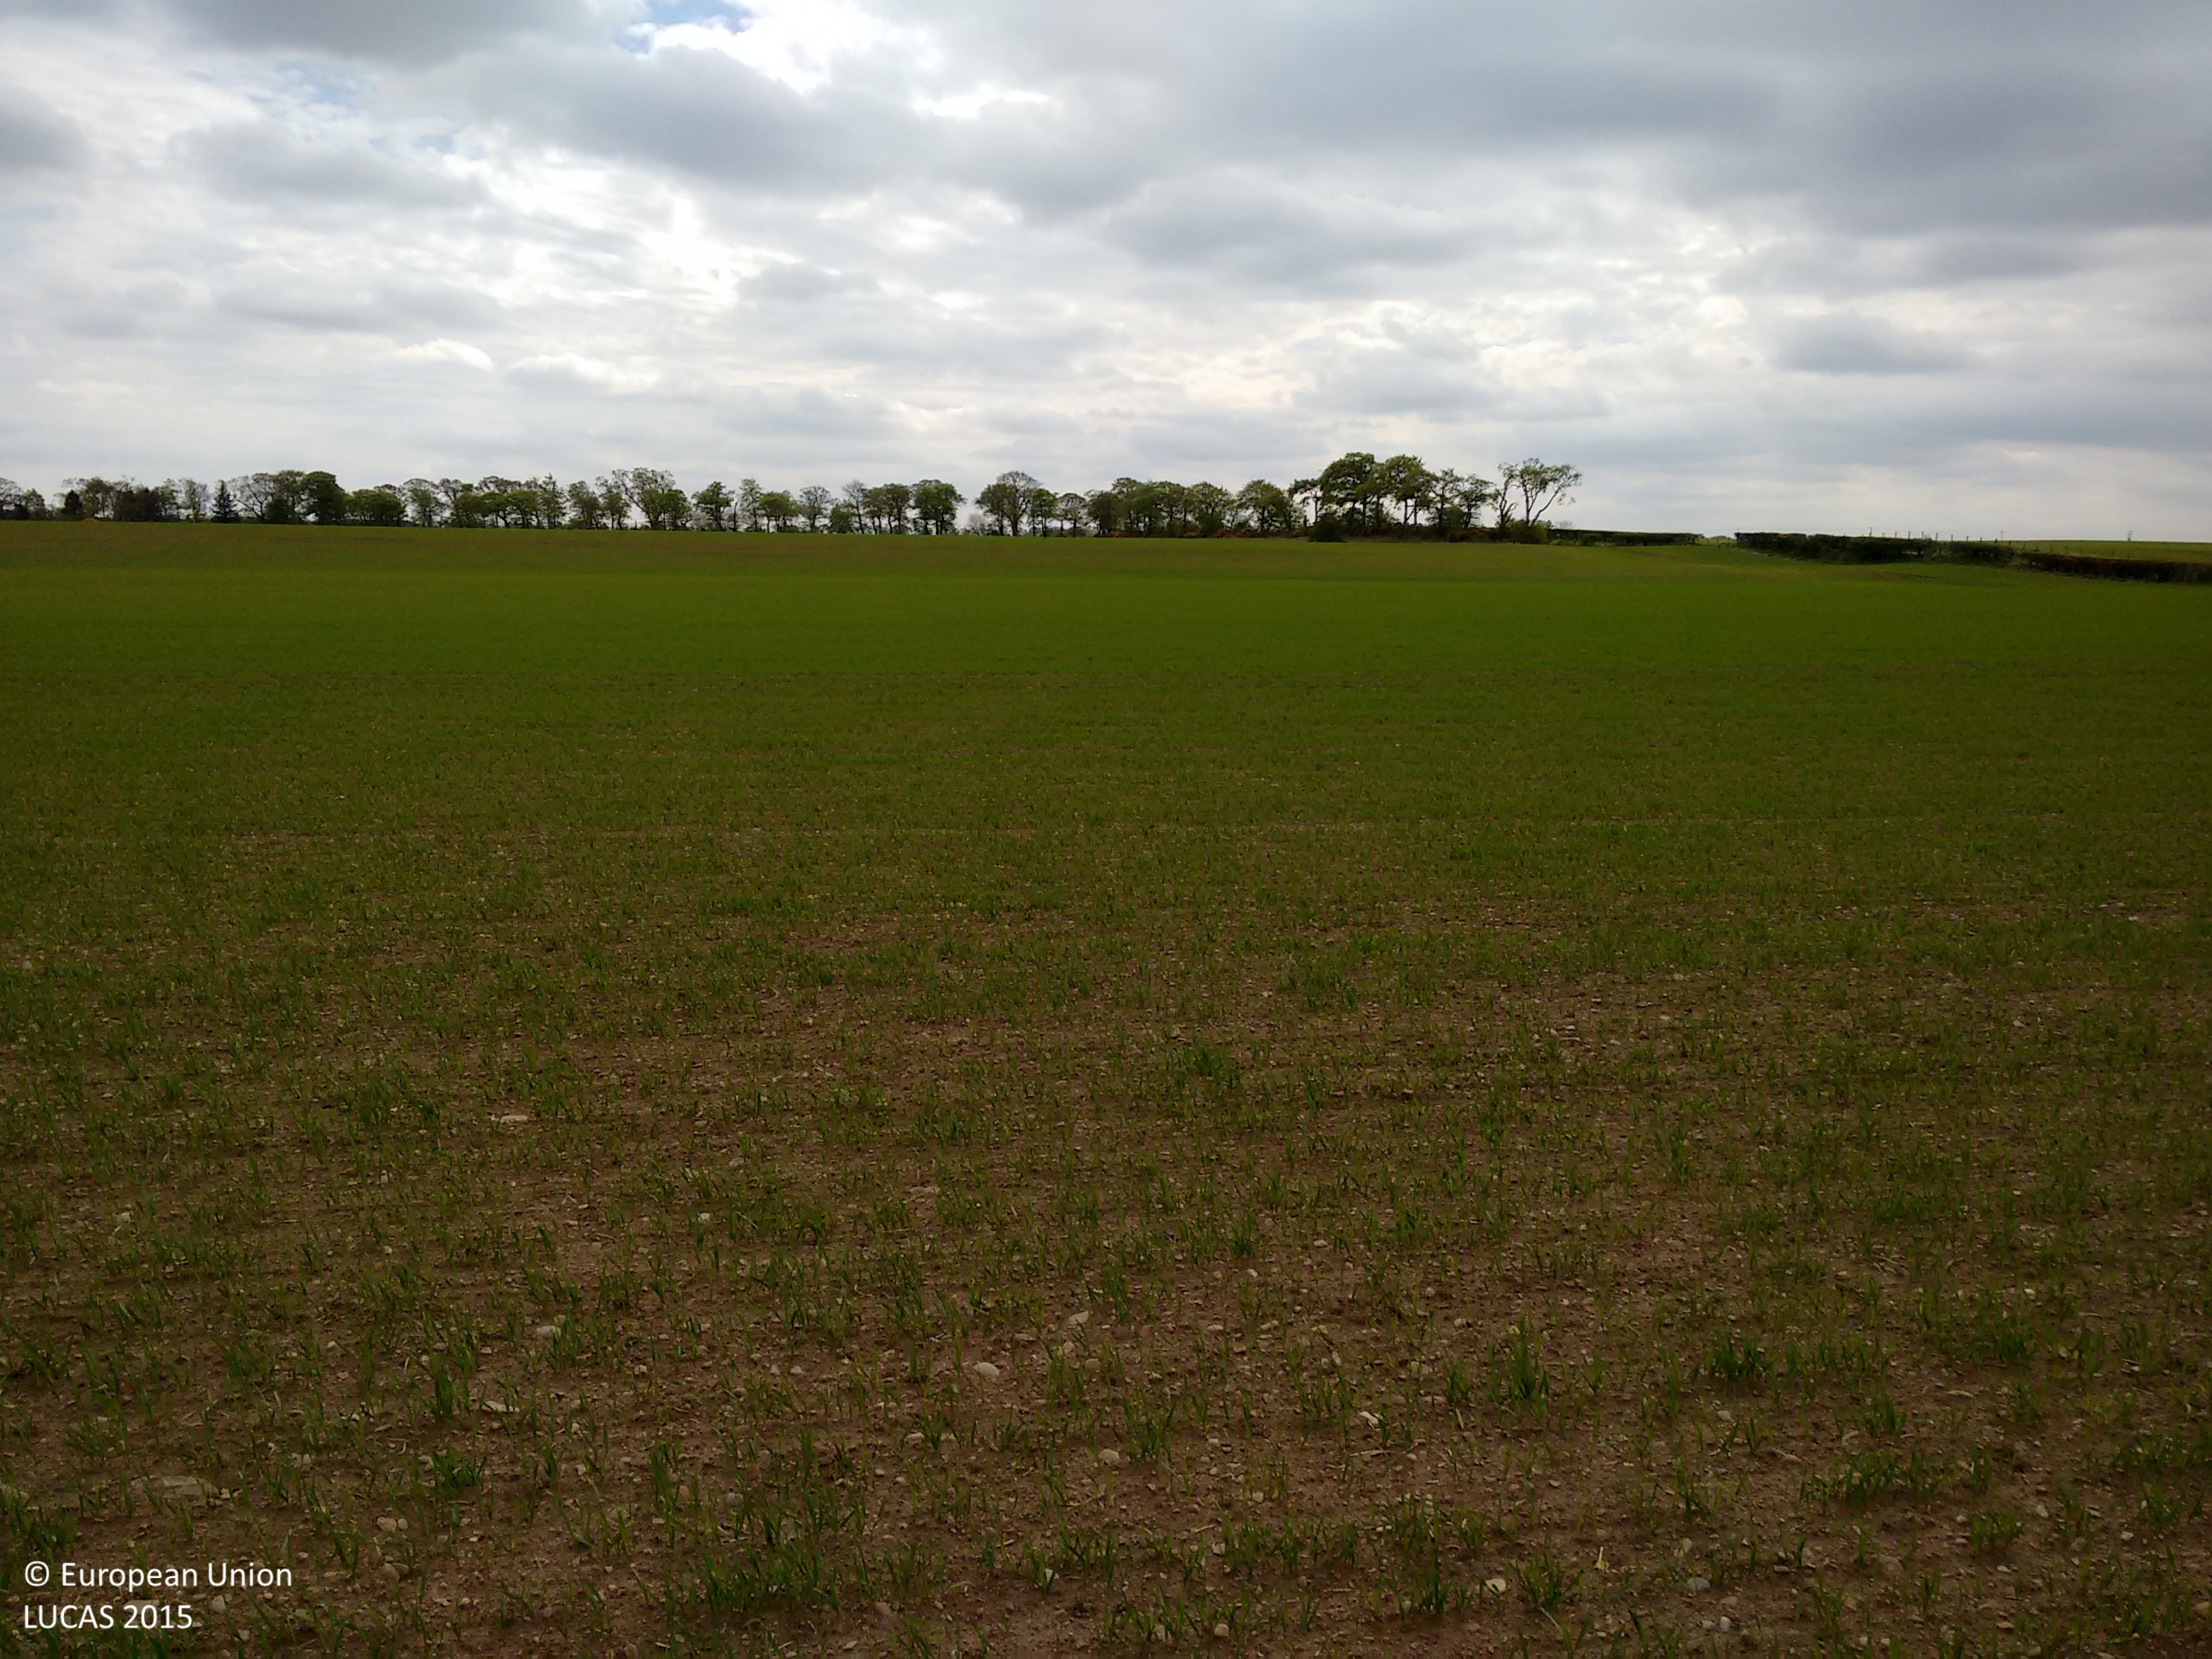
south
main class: Cropland
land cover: Oats
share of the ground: 50 - 75 %
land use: Agriculture (excluding fallow land and kitchen gardens)
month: May
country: GB
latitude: 56.7532
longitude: -2.7349
